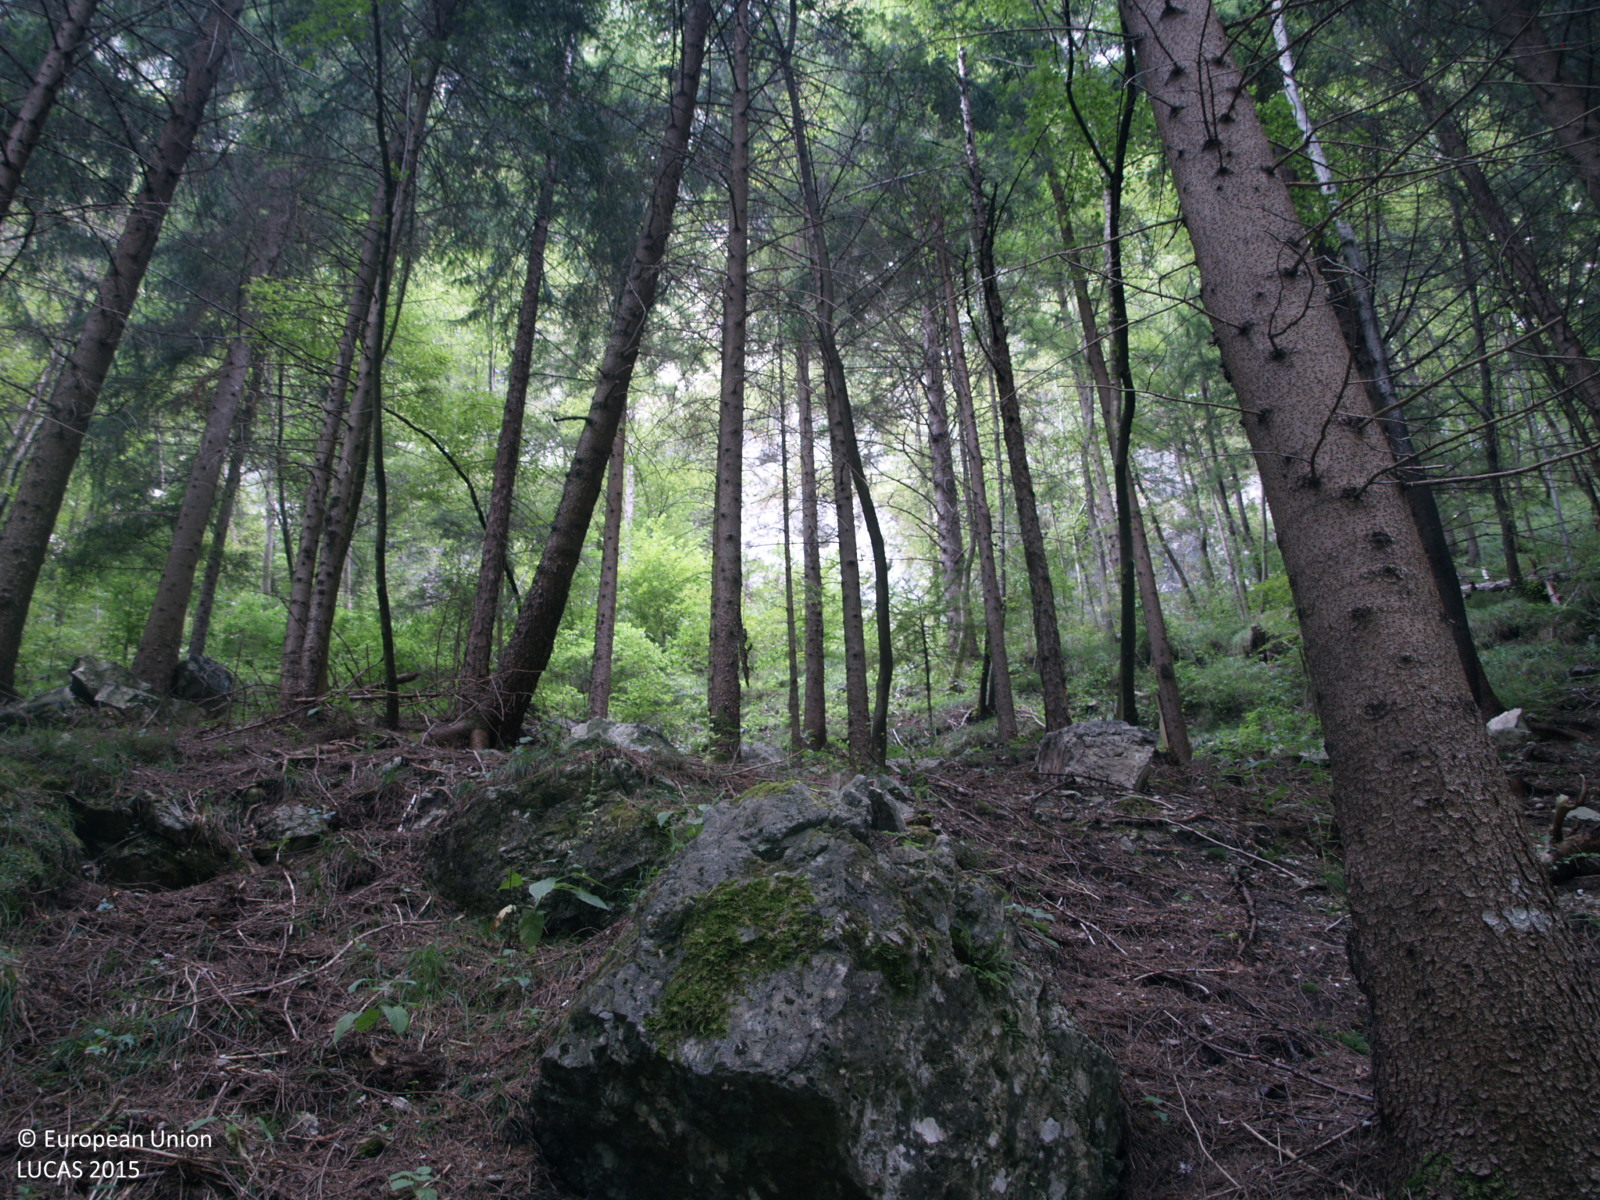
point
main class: Woodland
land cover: Spruce dominated coniferous woodland
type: alpine coniferous forest
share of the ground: > 75 %
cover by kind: coniferous forest trees 90 %, broadleaved forest trees 10 %
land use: Forestry
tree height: > 5 m
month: May
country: IT
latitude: 46.0249
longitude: 10.6579
